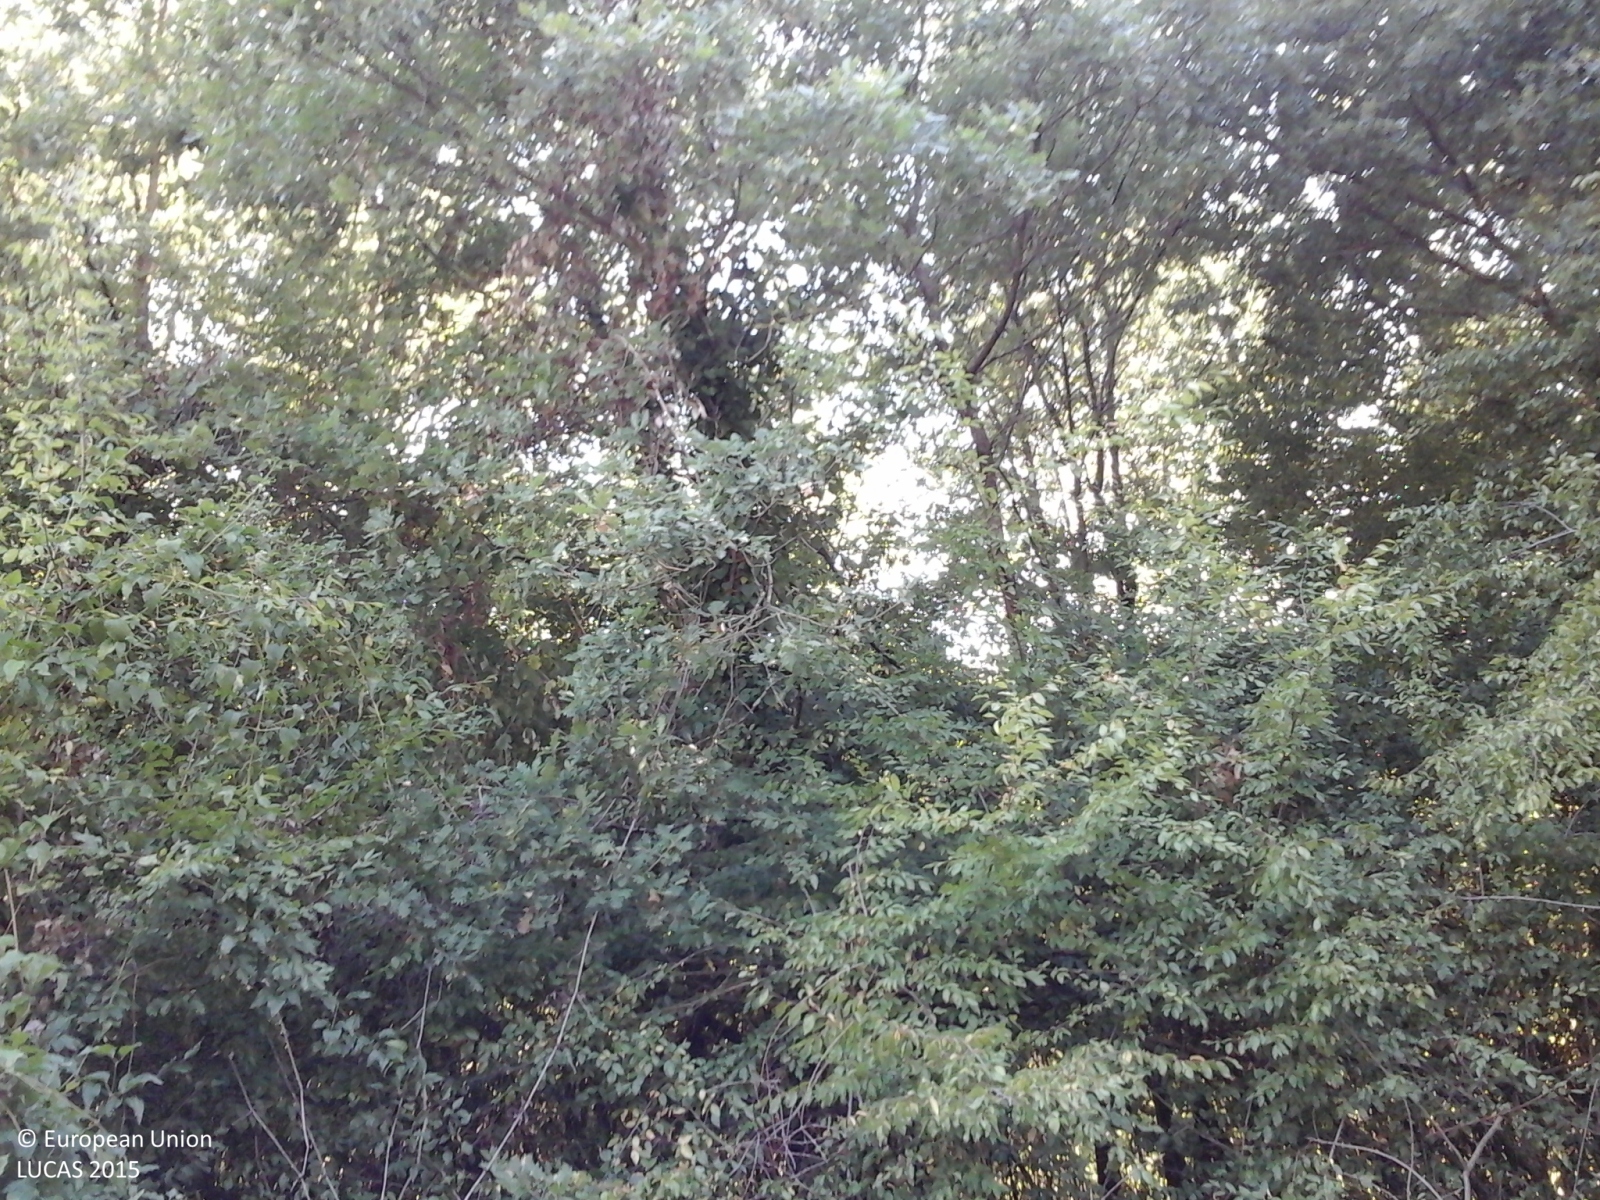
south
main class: Woodland
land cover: Broadleaved woodland
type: thermophilous deciduous forest
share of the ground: > 75 %
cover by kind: broadleaved forest trees 80 %, shrubs 15 %, herbaceous plants 5 %
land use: Semi-natural and natural areas not in use
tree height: > 5 m
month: September
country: IT
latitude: 41.6083
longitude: 14.1968
